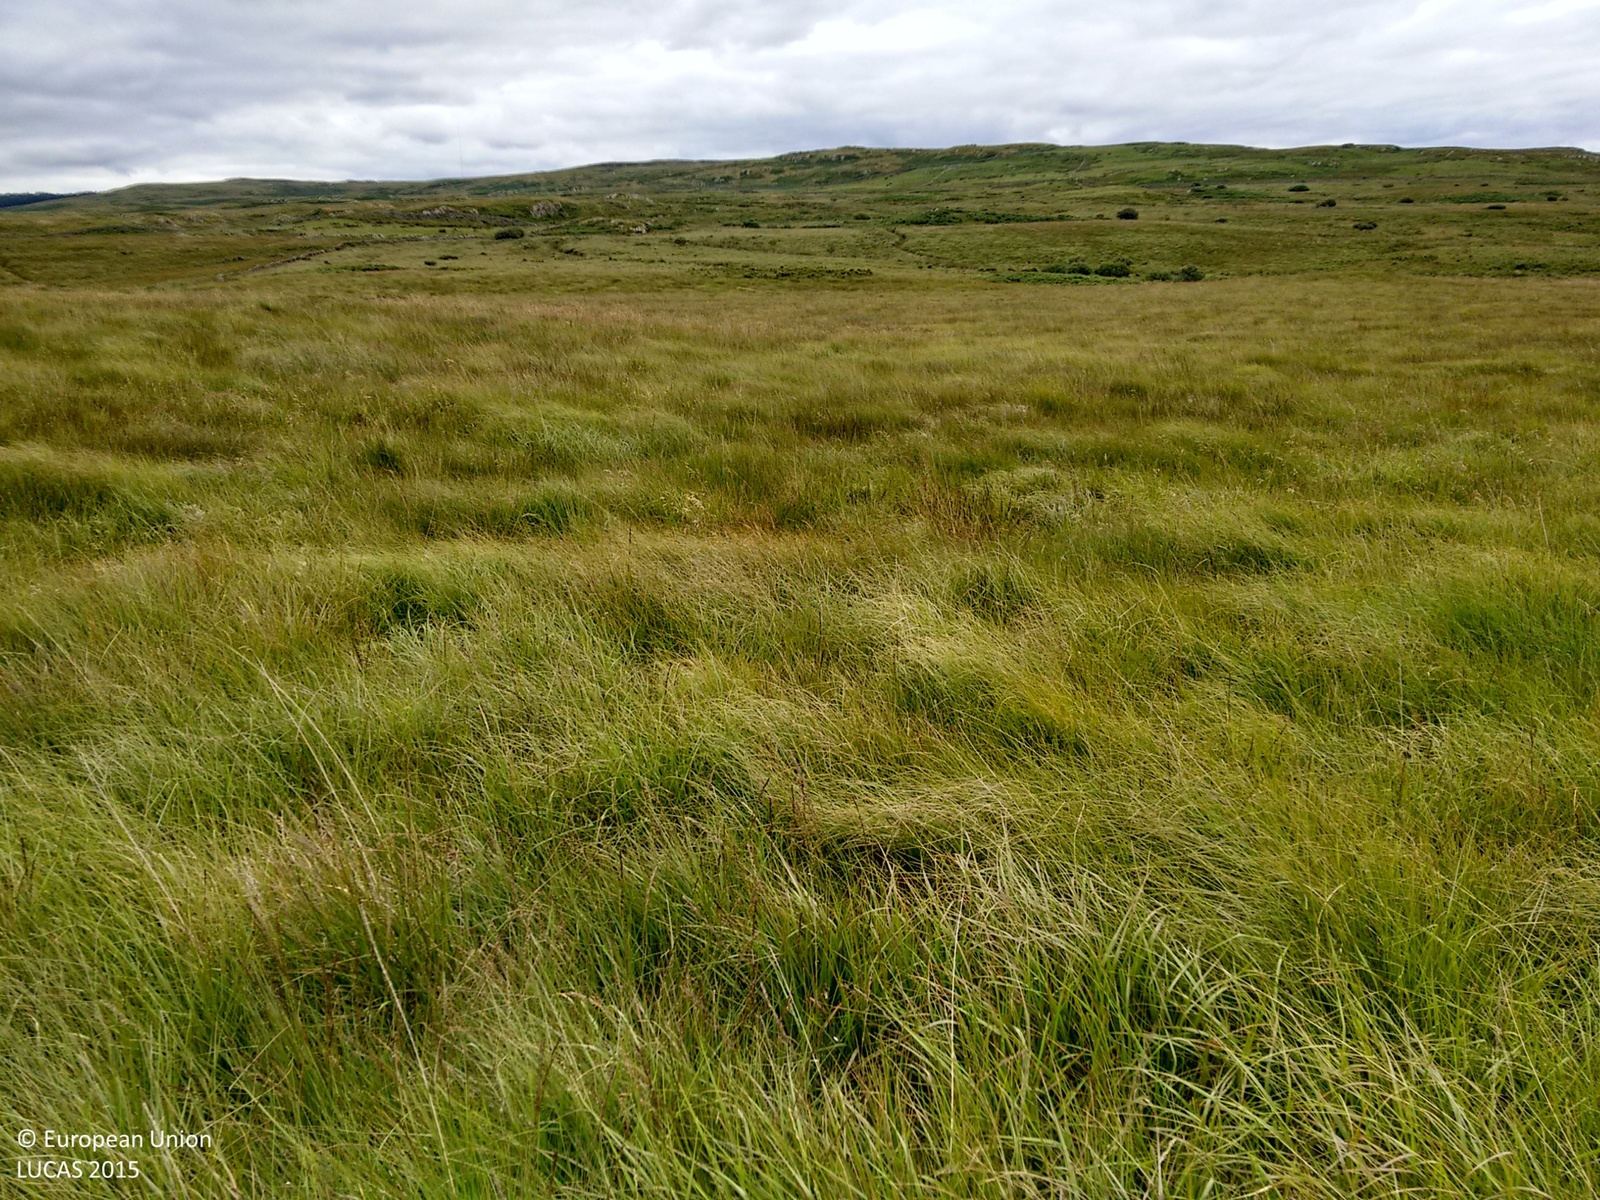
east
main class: Grassland
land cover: Grassland without tree/shrub cover
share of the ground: > 75 %
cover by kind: herbaceous plants 100 %
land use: Agriculture (excluding fallow land and kitchen gardens)
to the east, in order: Grassland without tree/shrub cover; Fences; Grass margins; Dry stone walls; Grassland without tree/shrub cover; Inland fresh running water; Grassland without tree/shrub cover; Inland fresh running water; Shrubland without tree cover; Grassland without tree/shrub cover; Rivers and streams; Grassland without tree/shrub cover
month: August
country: GB
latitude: 54.9874
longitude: -4.8471
